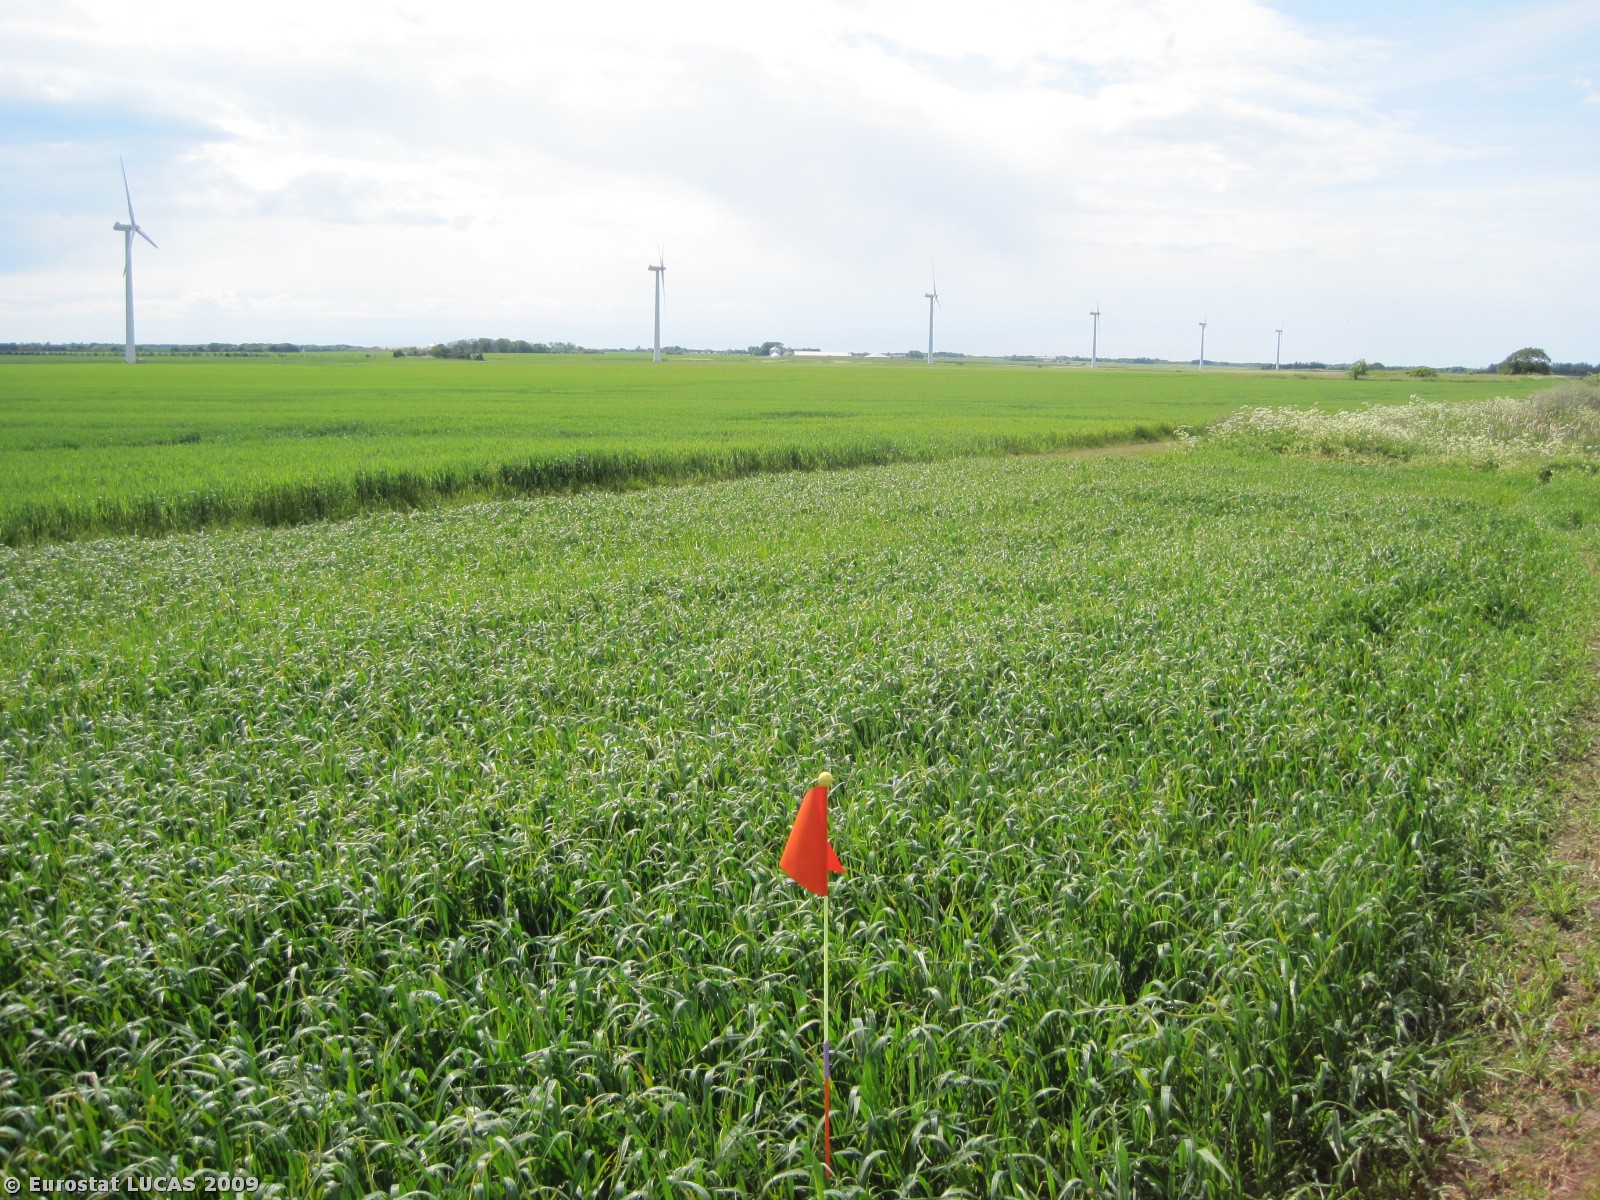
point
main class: Cropland
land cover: Rye
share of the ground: > 75 %
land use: Agriculture (excluding fallow land and kitchen gardens)
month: June
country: DK
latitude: 57.3382
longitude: 9.8507
